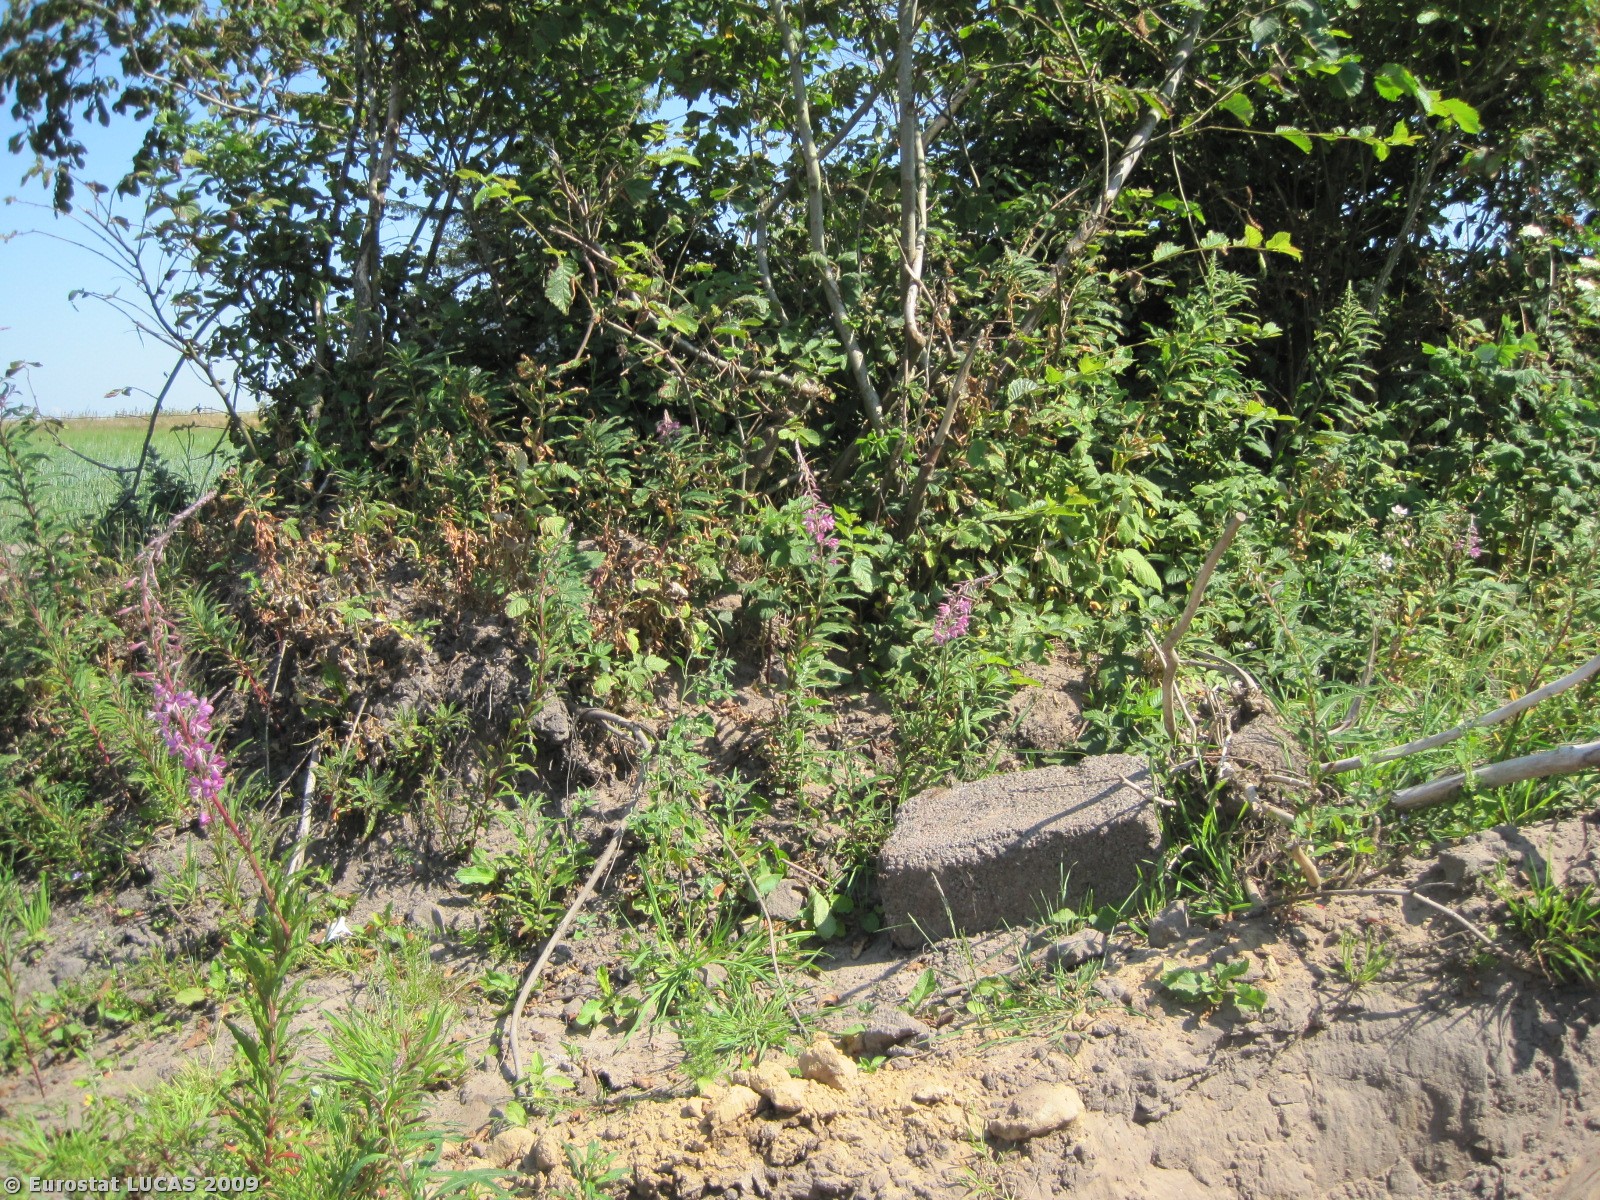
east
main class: Bare land
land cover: Bare land
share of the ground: > 75 %
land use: Unused
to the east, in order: Bare land; Tracks; Grass margins; Barley; Fences; Rye
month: July
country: DK
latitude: 56.4107
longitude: 8.3326
